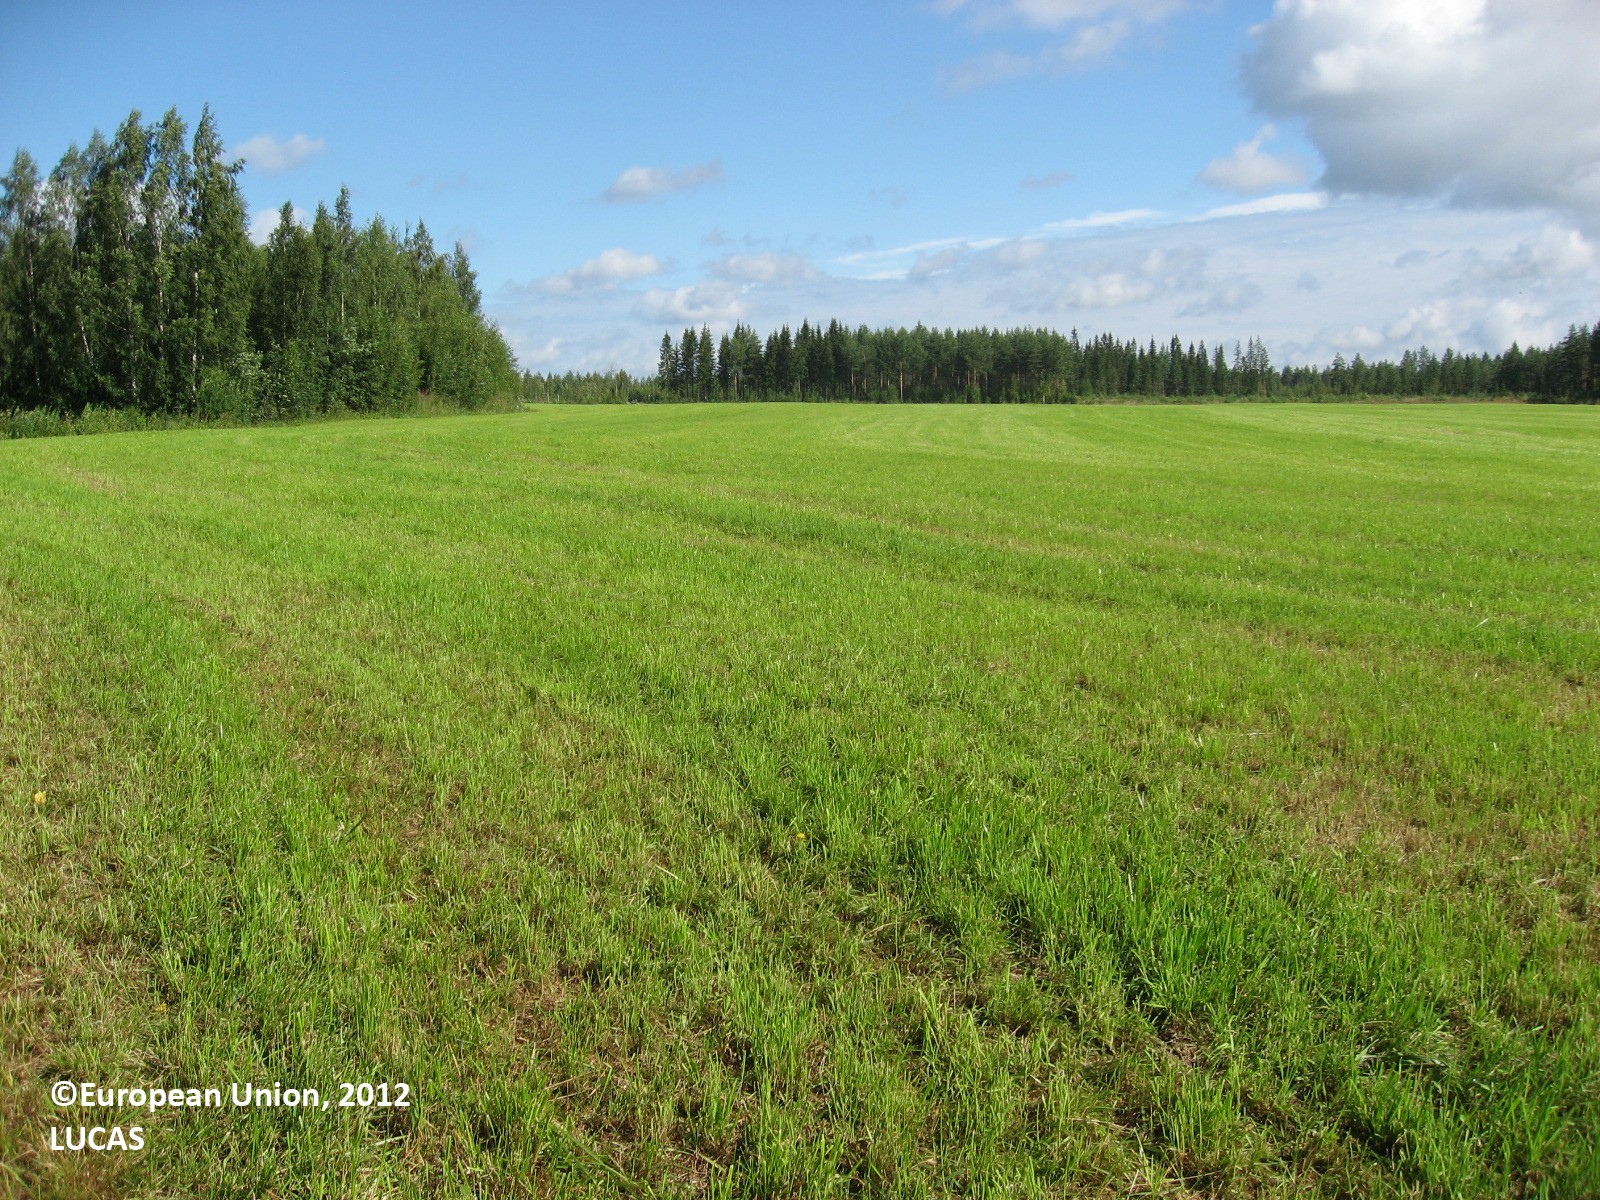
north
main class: Cropland
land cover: Temporary grasslands
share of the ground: > 75 %
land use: Agriculture (excluding fallow land and kitchen gardens)
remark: Harvested field
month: July
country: FI
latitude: 61.2837
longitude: 26.5123
